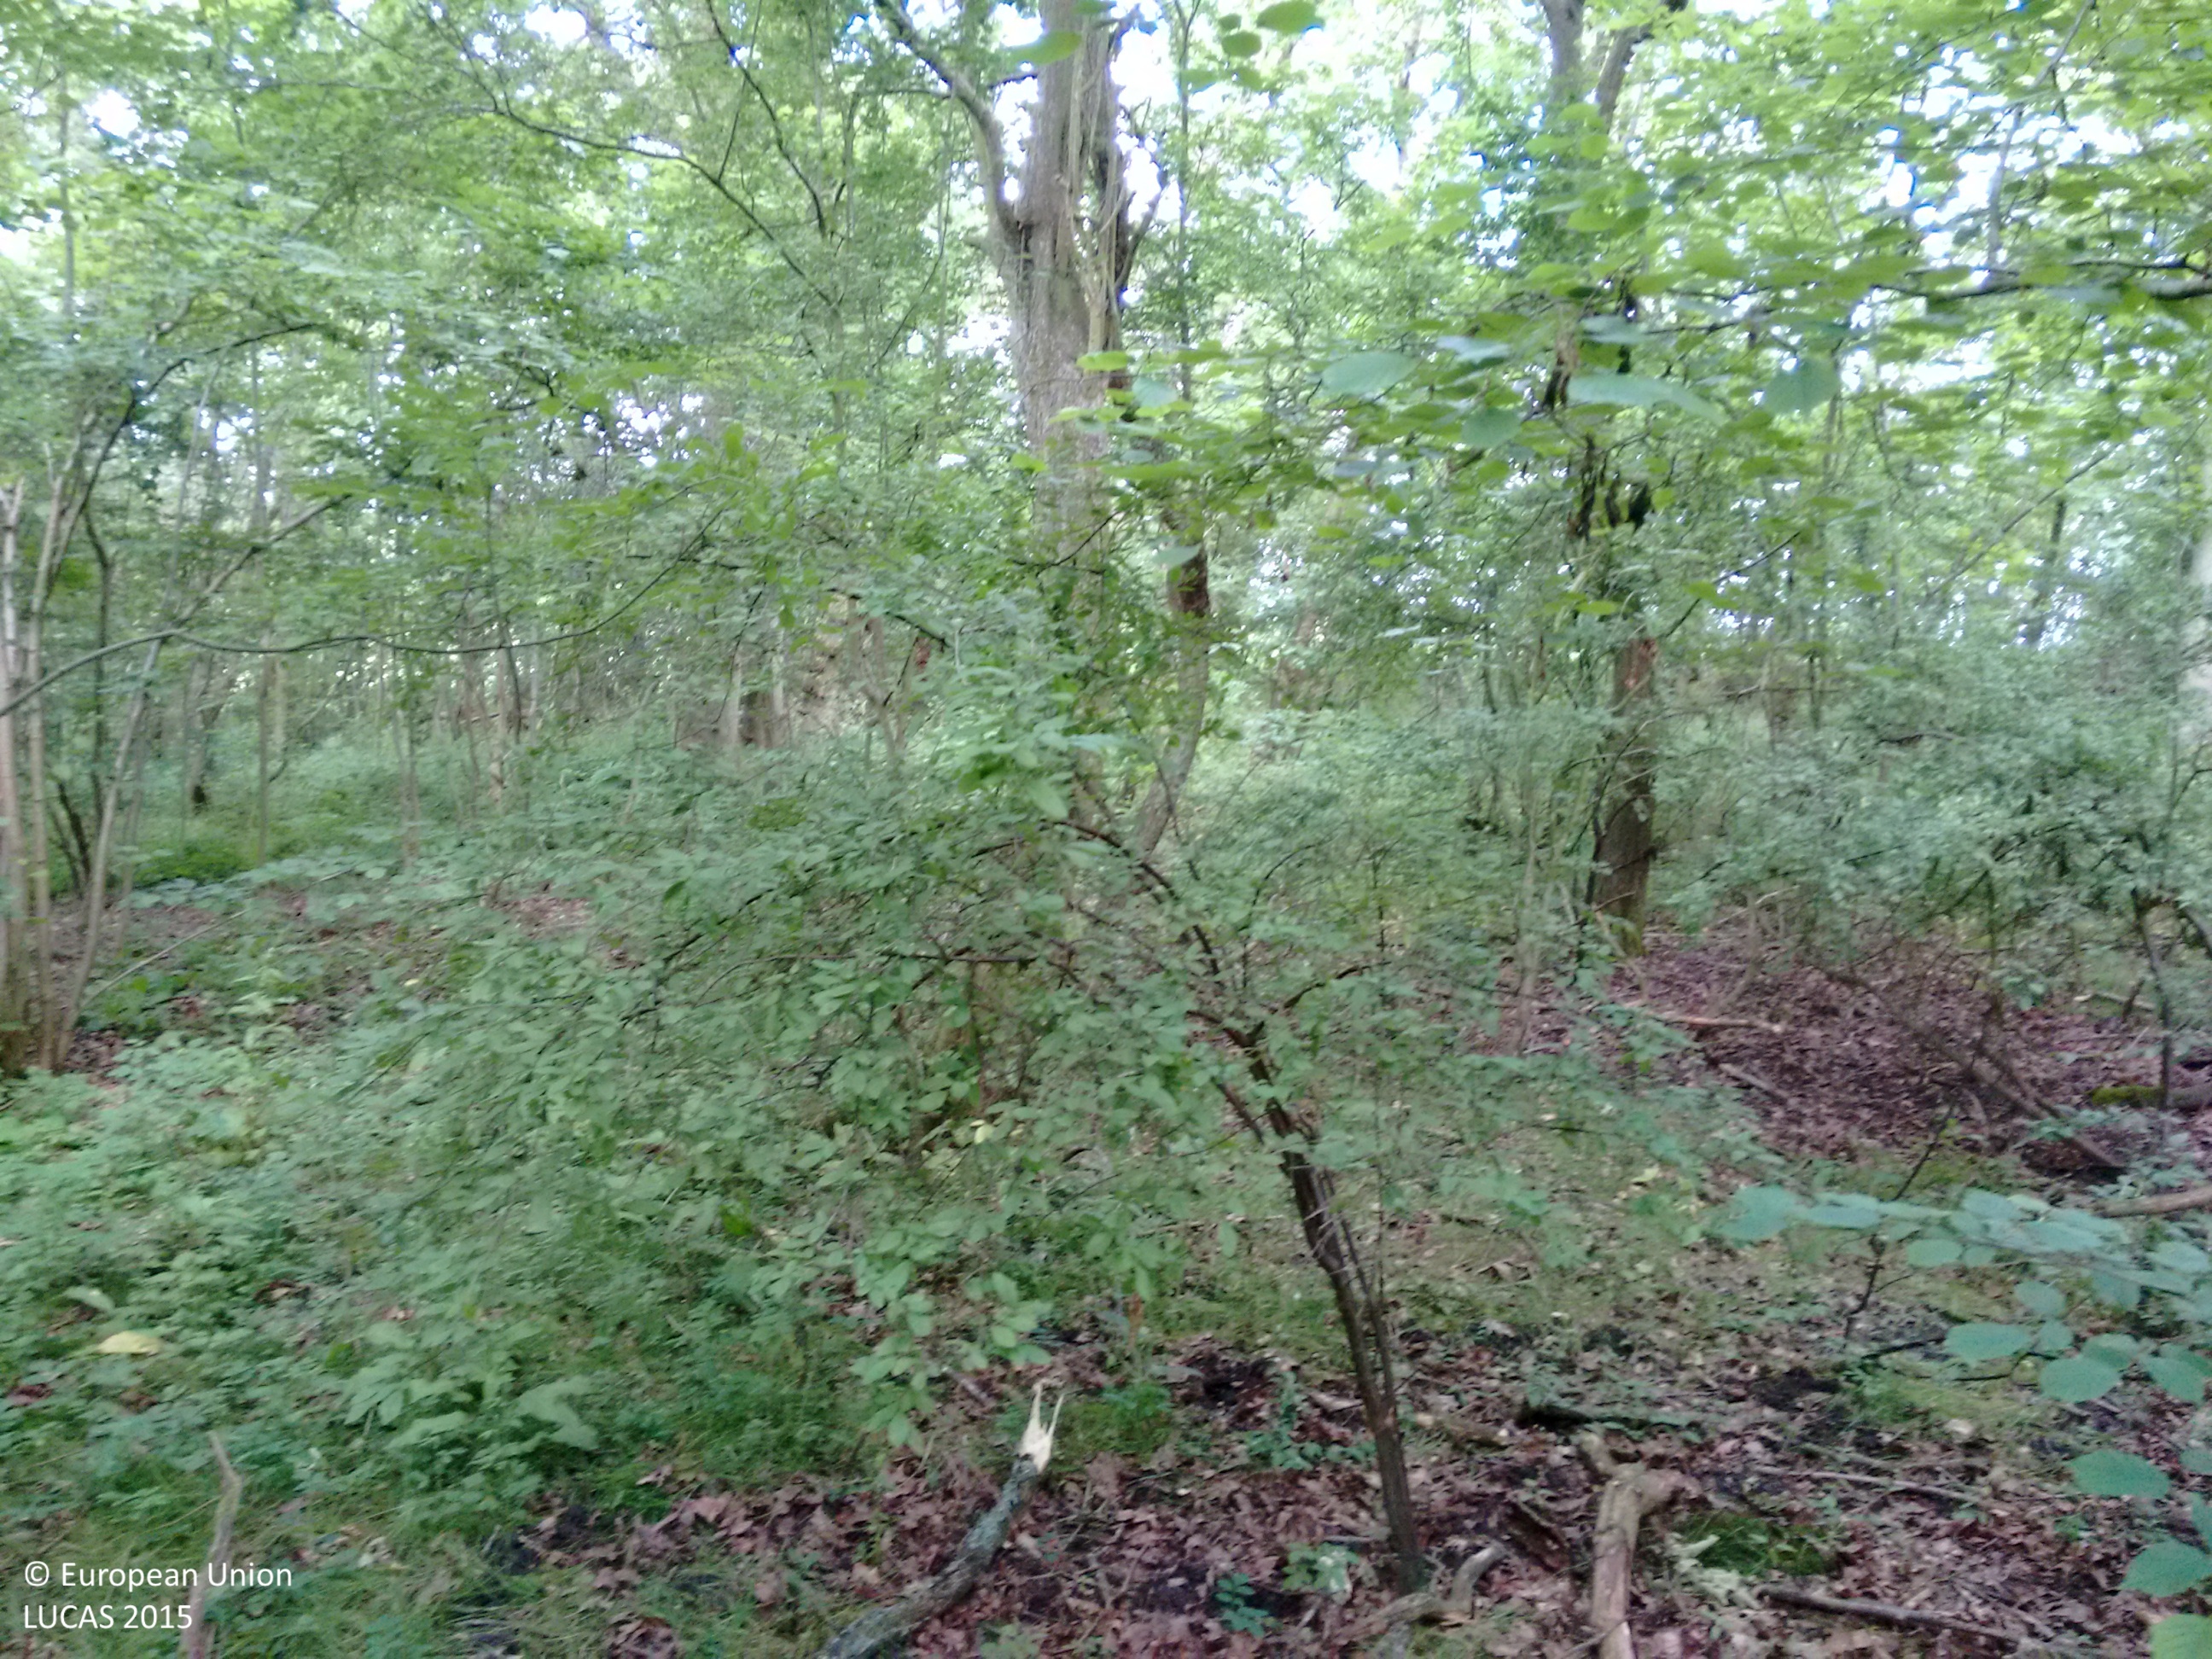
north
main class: Woodland
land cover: Broadleaved woodland
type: mesophytic deciduous forest
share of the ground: > 75 %
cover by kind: broadleaved forest trees 90 %, herbaceous plants 10 %
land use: Semi-natural and natural areas not in use
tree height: > 5 m
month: June
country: GB
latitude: 52.1291
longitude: -0.6897
